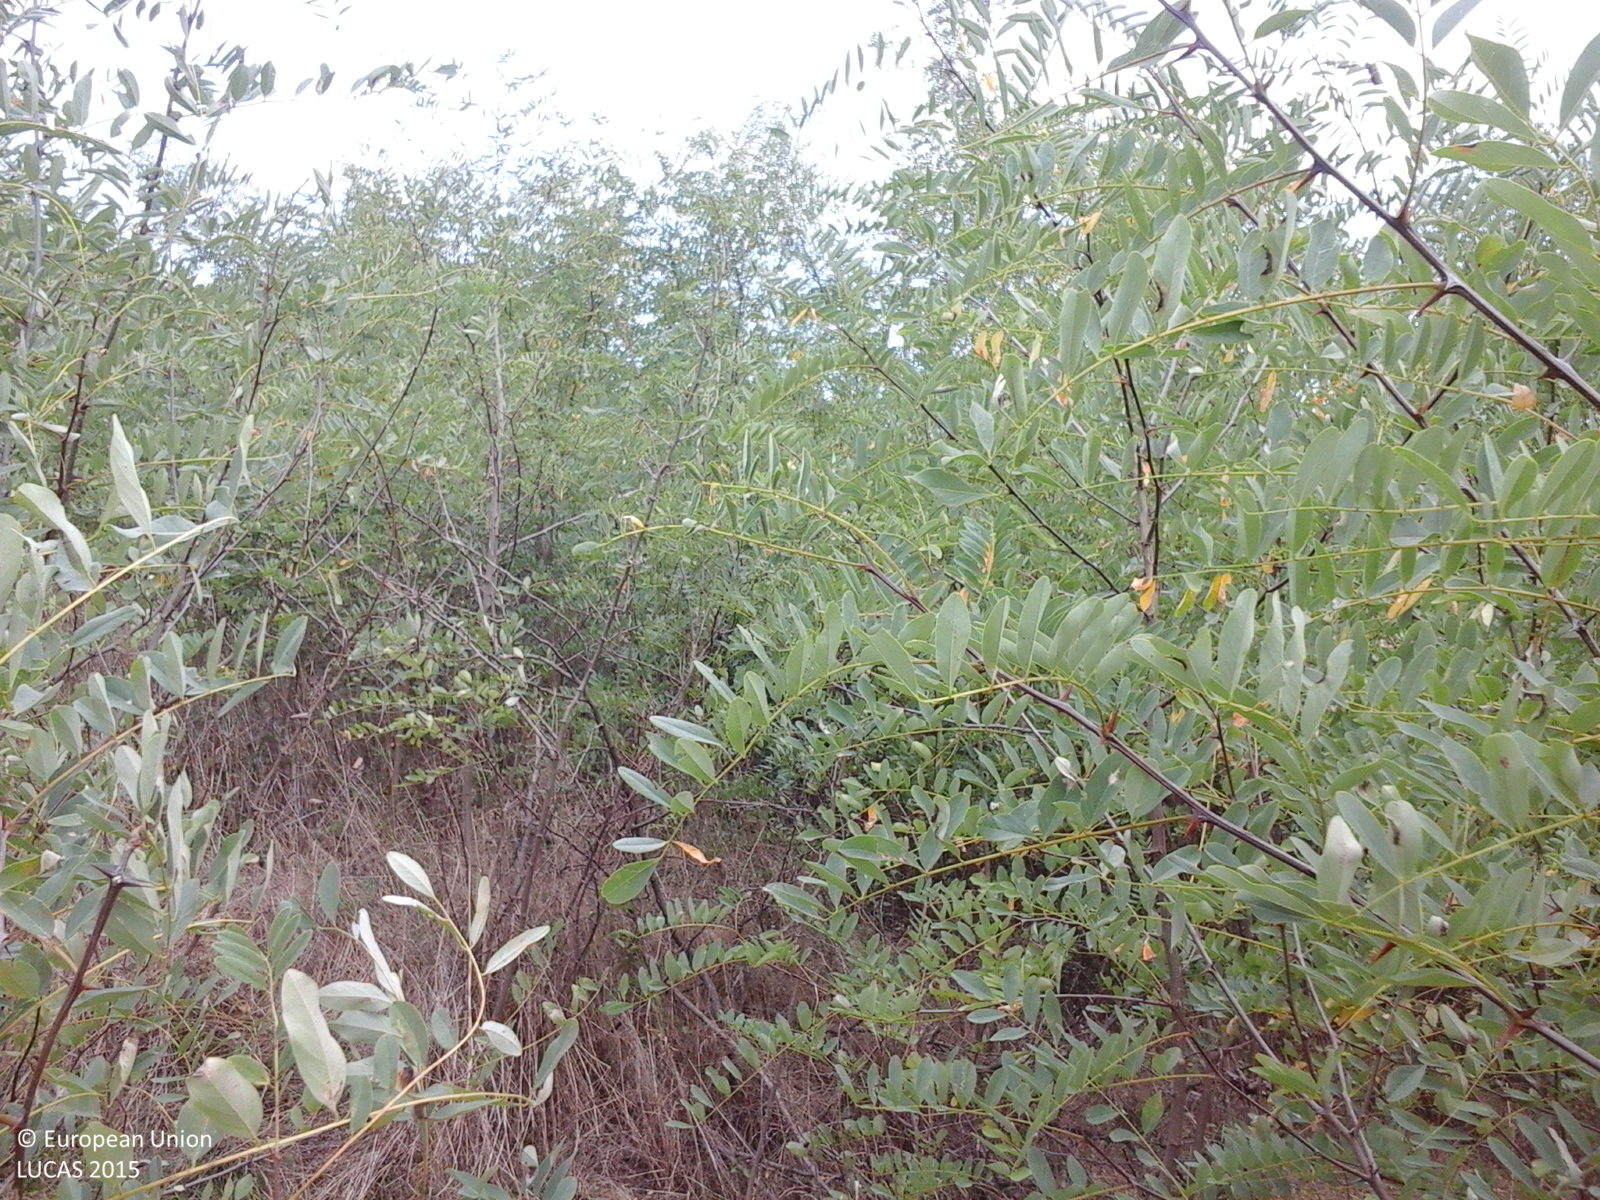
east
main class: Woodland
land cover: Broadleaved woodland
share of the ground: > 75 %
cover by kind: broadleaved forest trees 100 %
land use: Forestry
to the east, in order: Broadleaved woodland; Electric lines; Broadleaved woodland; Grassland without tree/shrub cover; Shrubland with sparse tree cover; Grassland without tree/shrub cover; Tracks; Grassland without tree/shrub cover
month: September
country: RO
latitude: 45.4081
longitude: 22.2431
